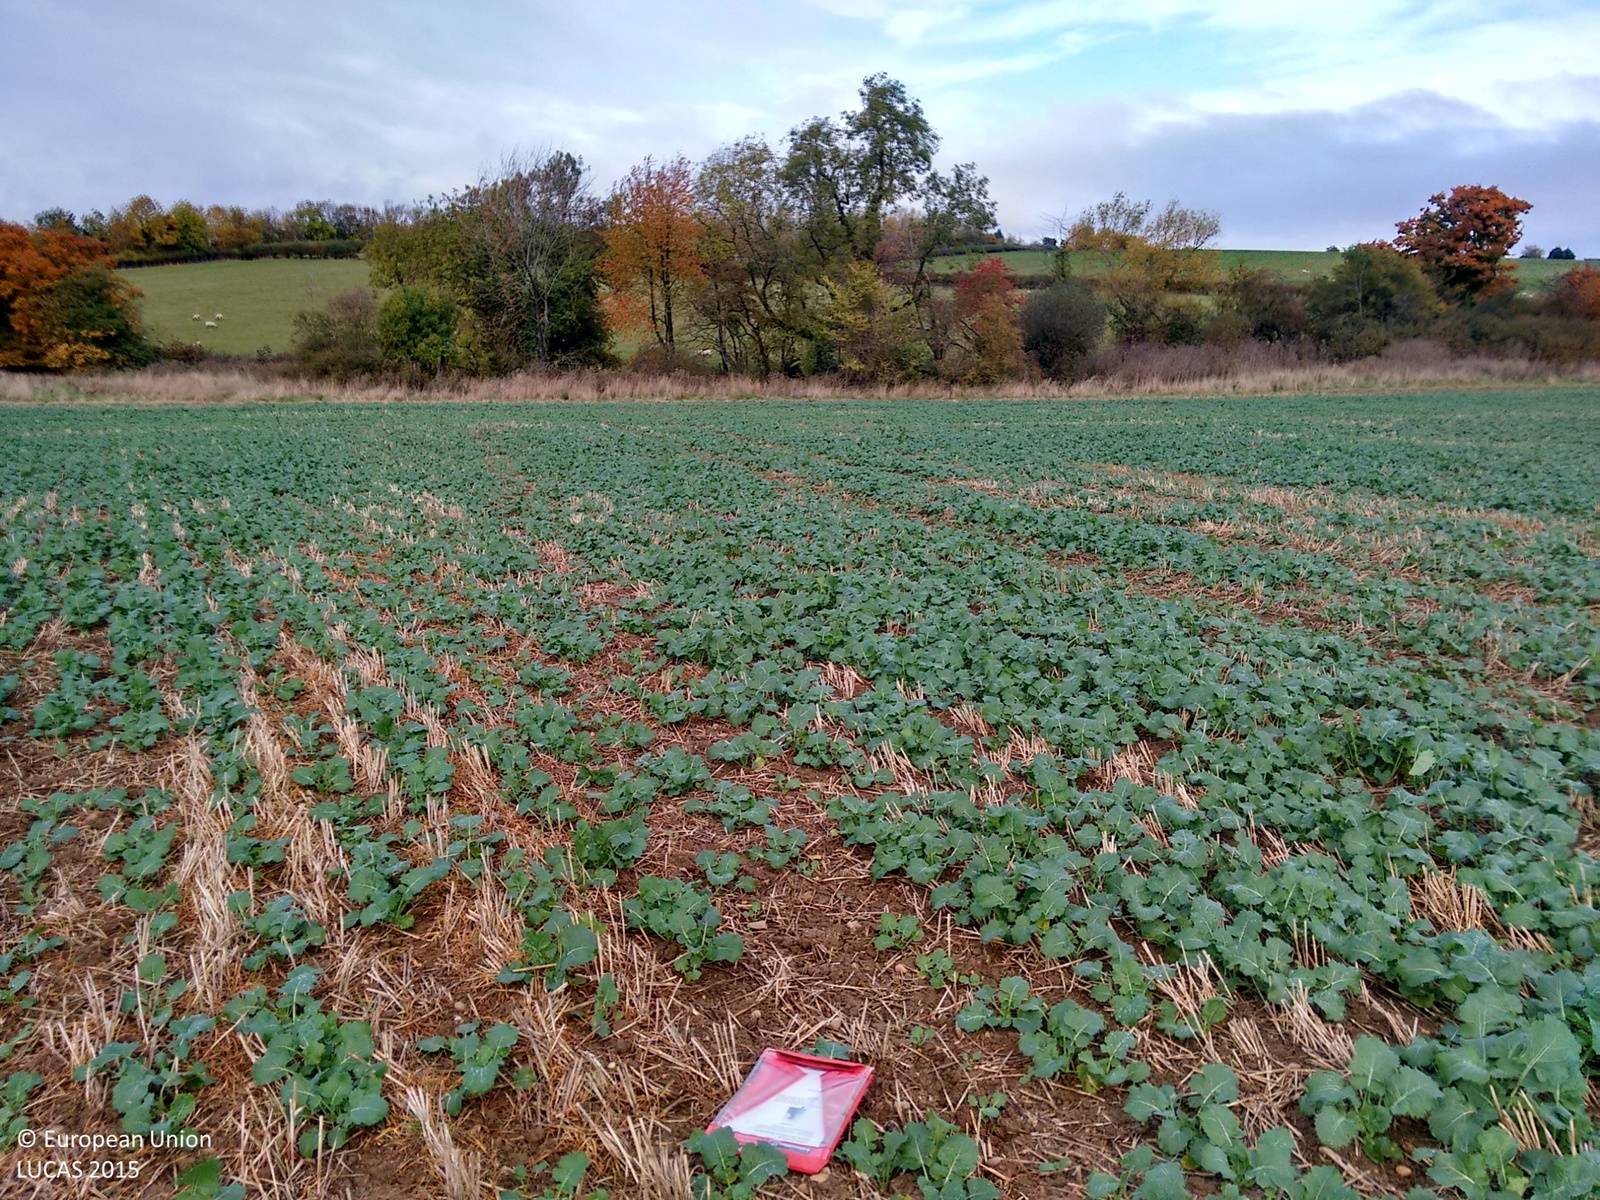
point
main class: Cropland
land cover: Rape and turnip rape
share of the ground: 50 - 75 %
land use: Agriculture (excluding fallow land and kitchen gardens)
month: October
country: GB
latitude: 52.0356
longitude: -1.6718
